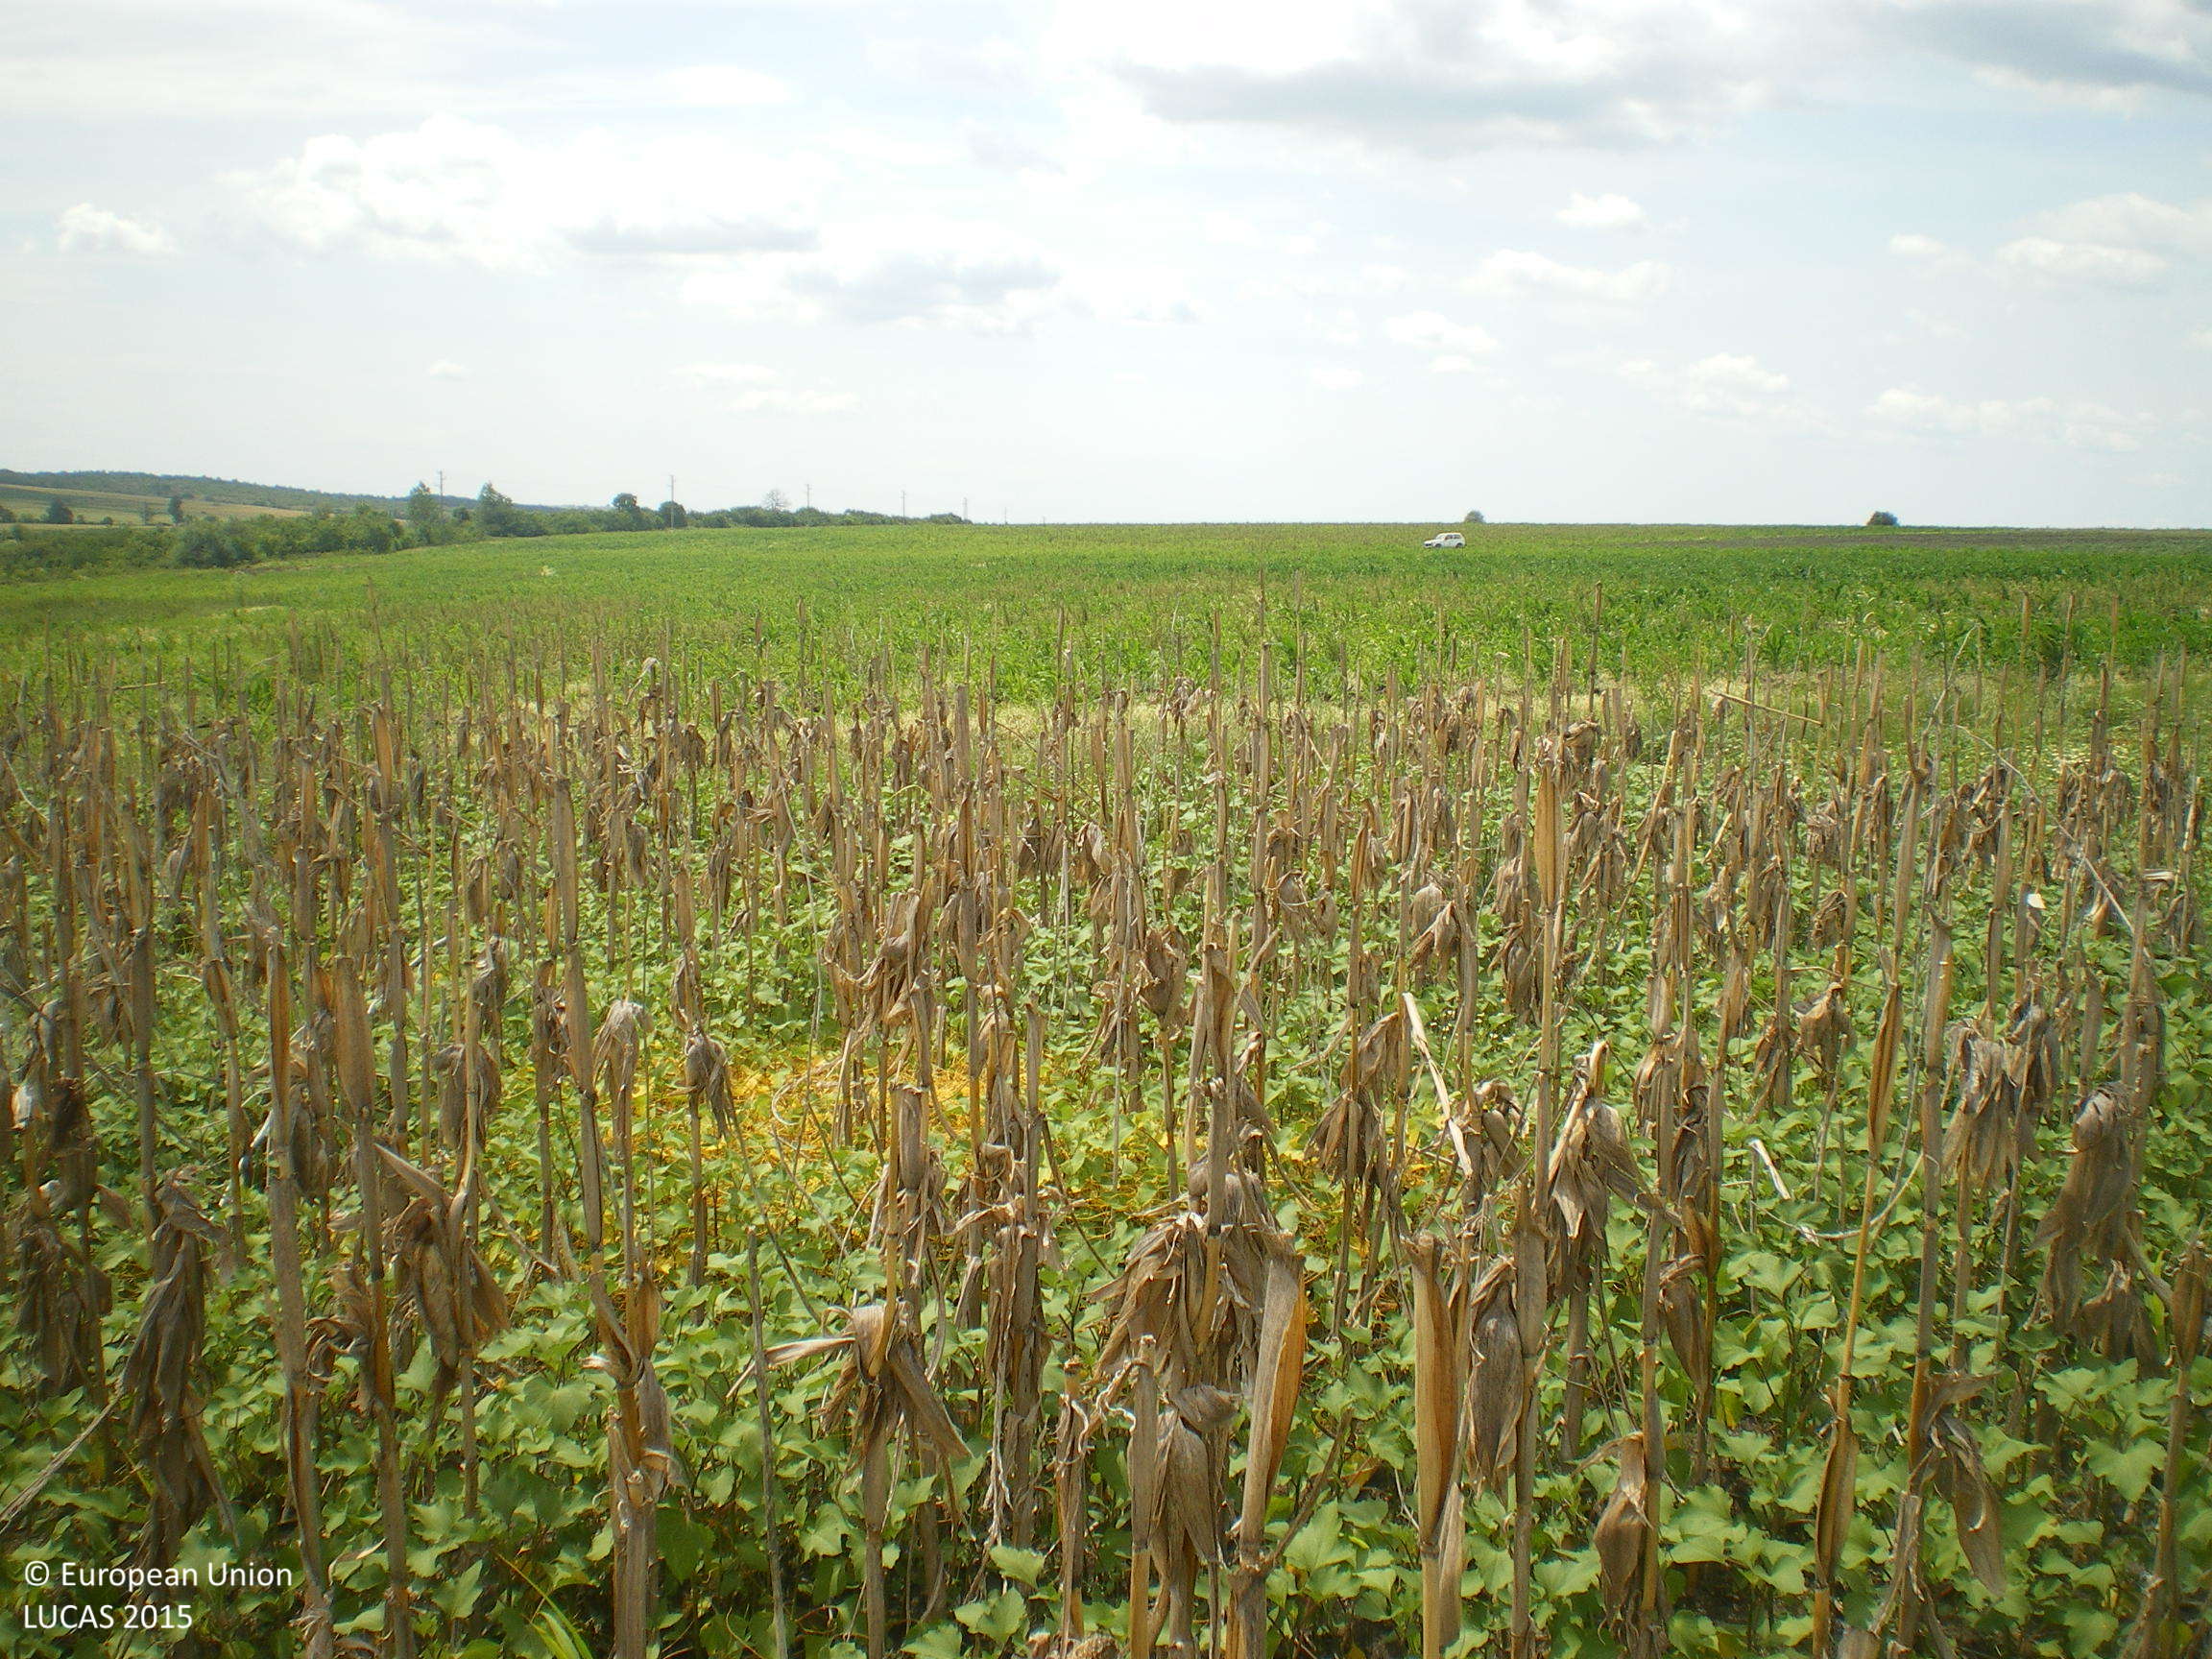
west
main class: Grassland
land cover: Spontaneously vegetated surfaces
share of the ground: > 75 %
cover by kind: herbaceous plants 85 %, unconsolidated bare surface 15 %
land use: Fallow land
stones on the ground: < 10 %
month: June
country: BG
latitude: 42.0096
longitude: 25.4584
